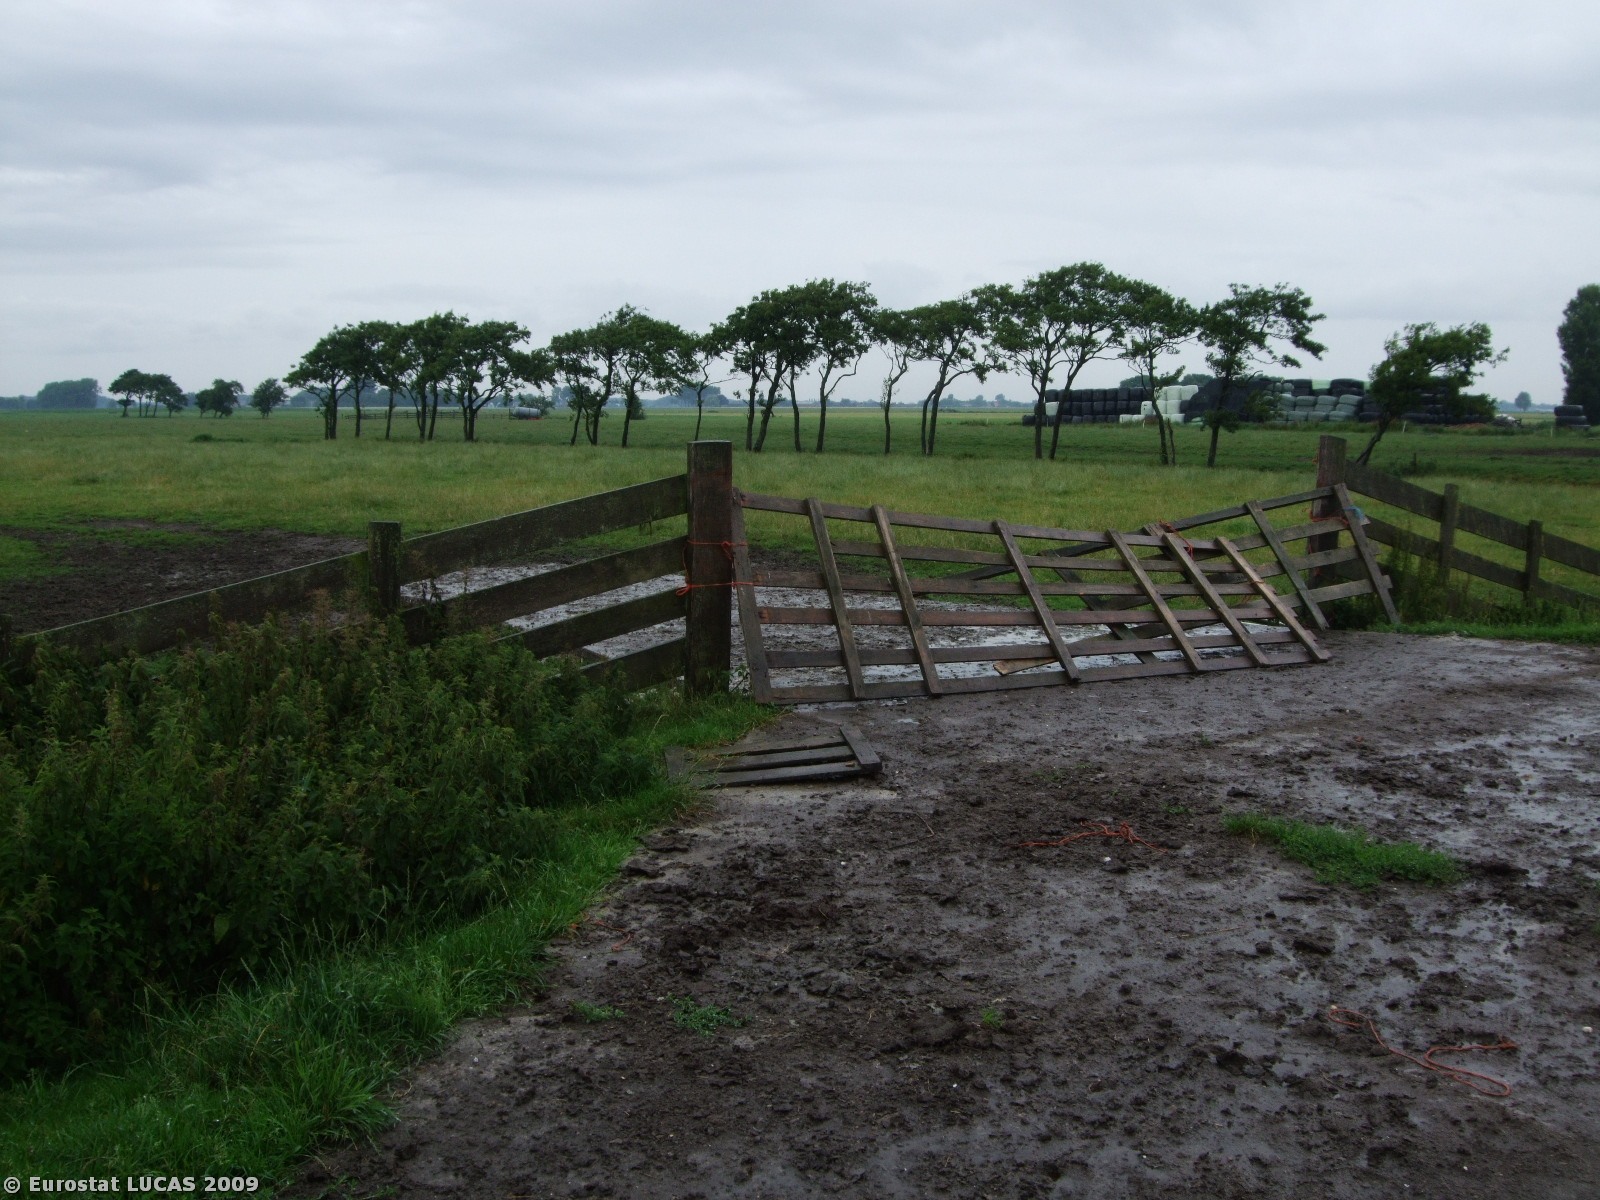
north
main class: Grassland
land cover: Grassland without tree/shrub cover
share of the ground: > 75 %
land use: Agriculture (excluding fallow land and kitchen gardens)
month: July
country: NL
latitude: 53.2144
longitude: 5.6113
